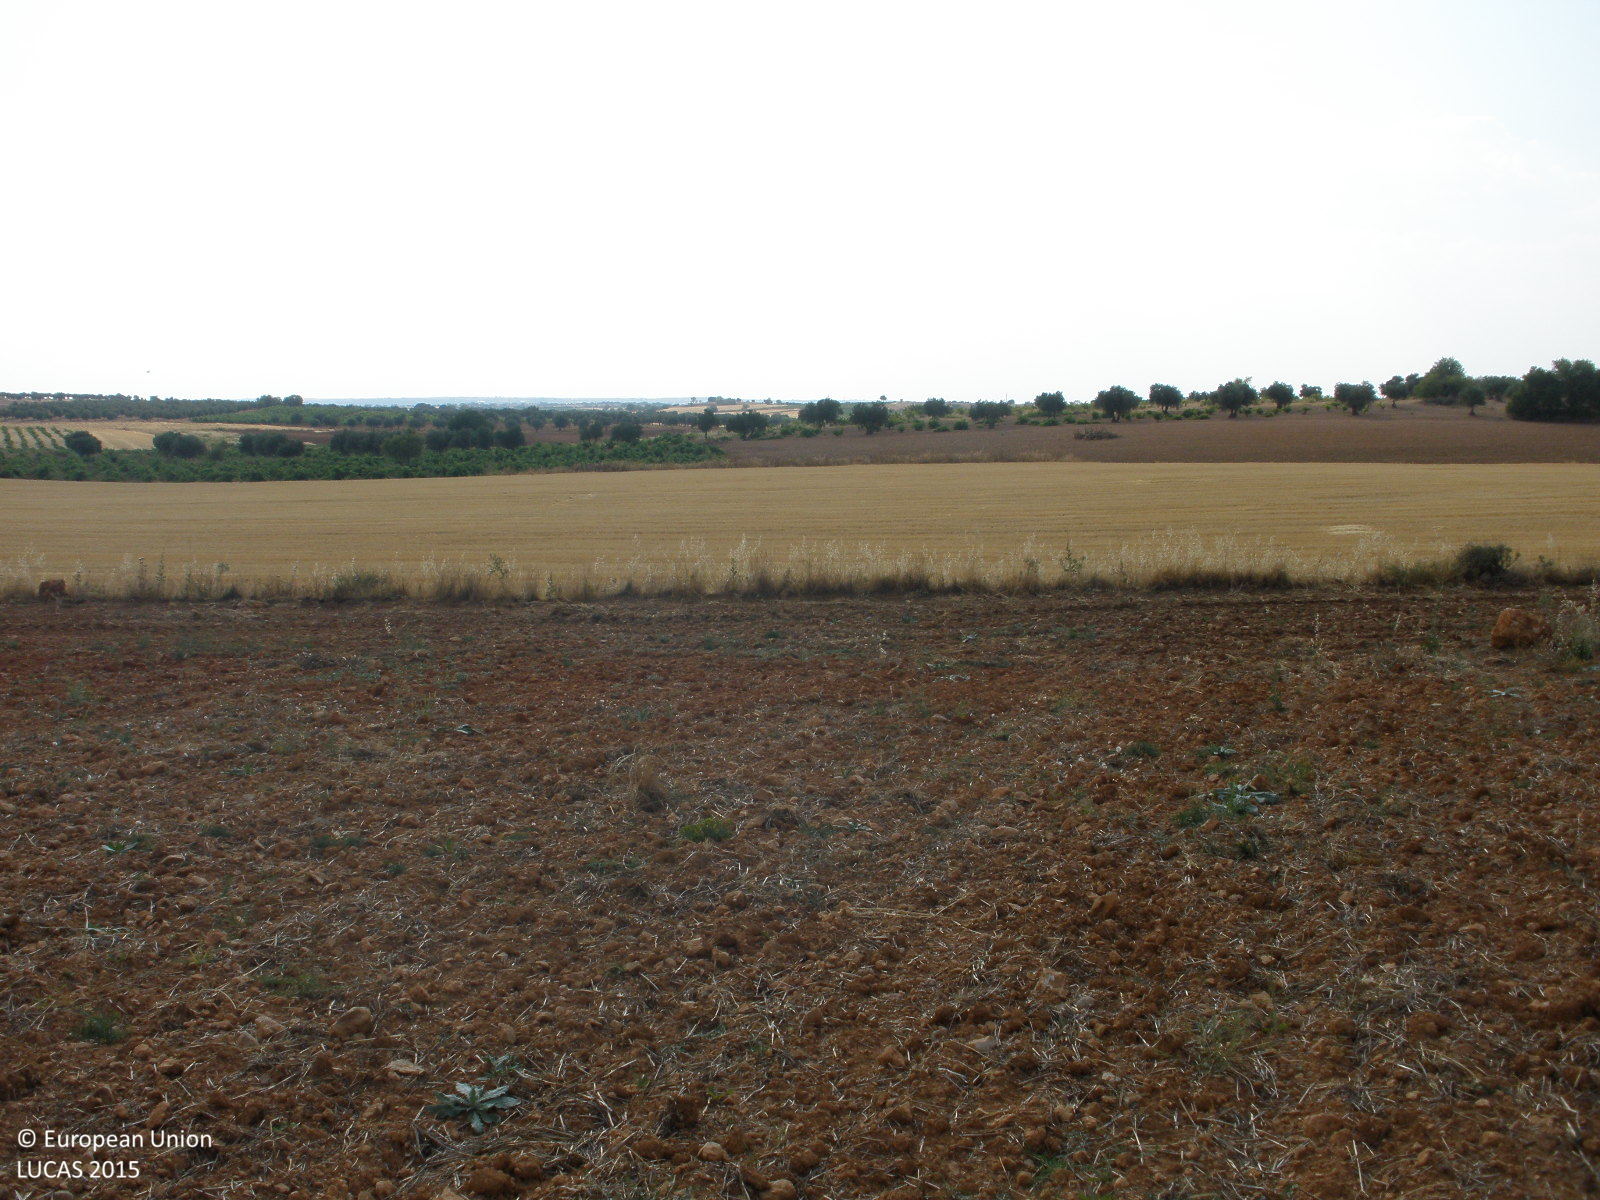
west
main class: Grassland
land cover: Spontaneously vegetated surfaces
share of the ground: 10 - 25 %
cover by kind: unconsolidated bare surface 80 %, herbaceous plants 20 %
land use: Fallow land
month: June
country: ES
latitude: 40.1472
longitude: -3.2815
